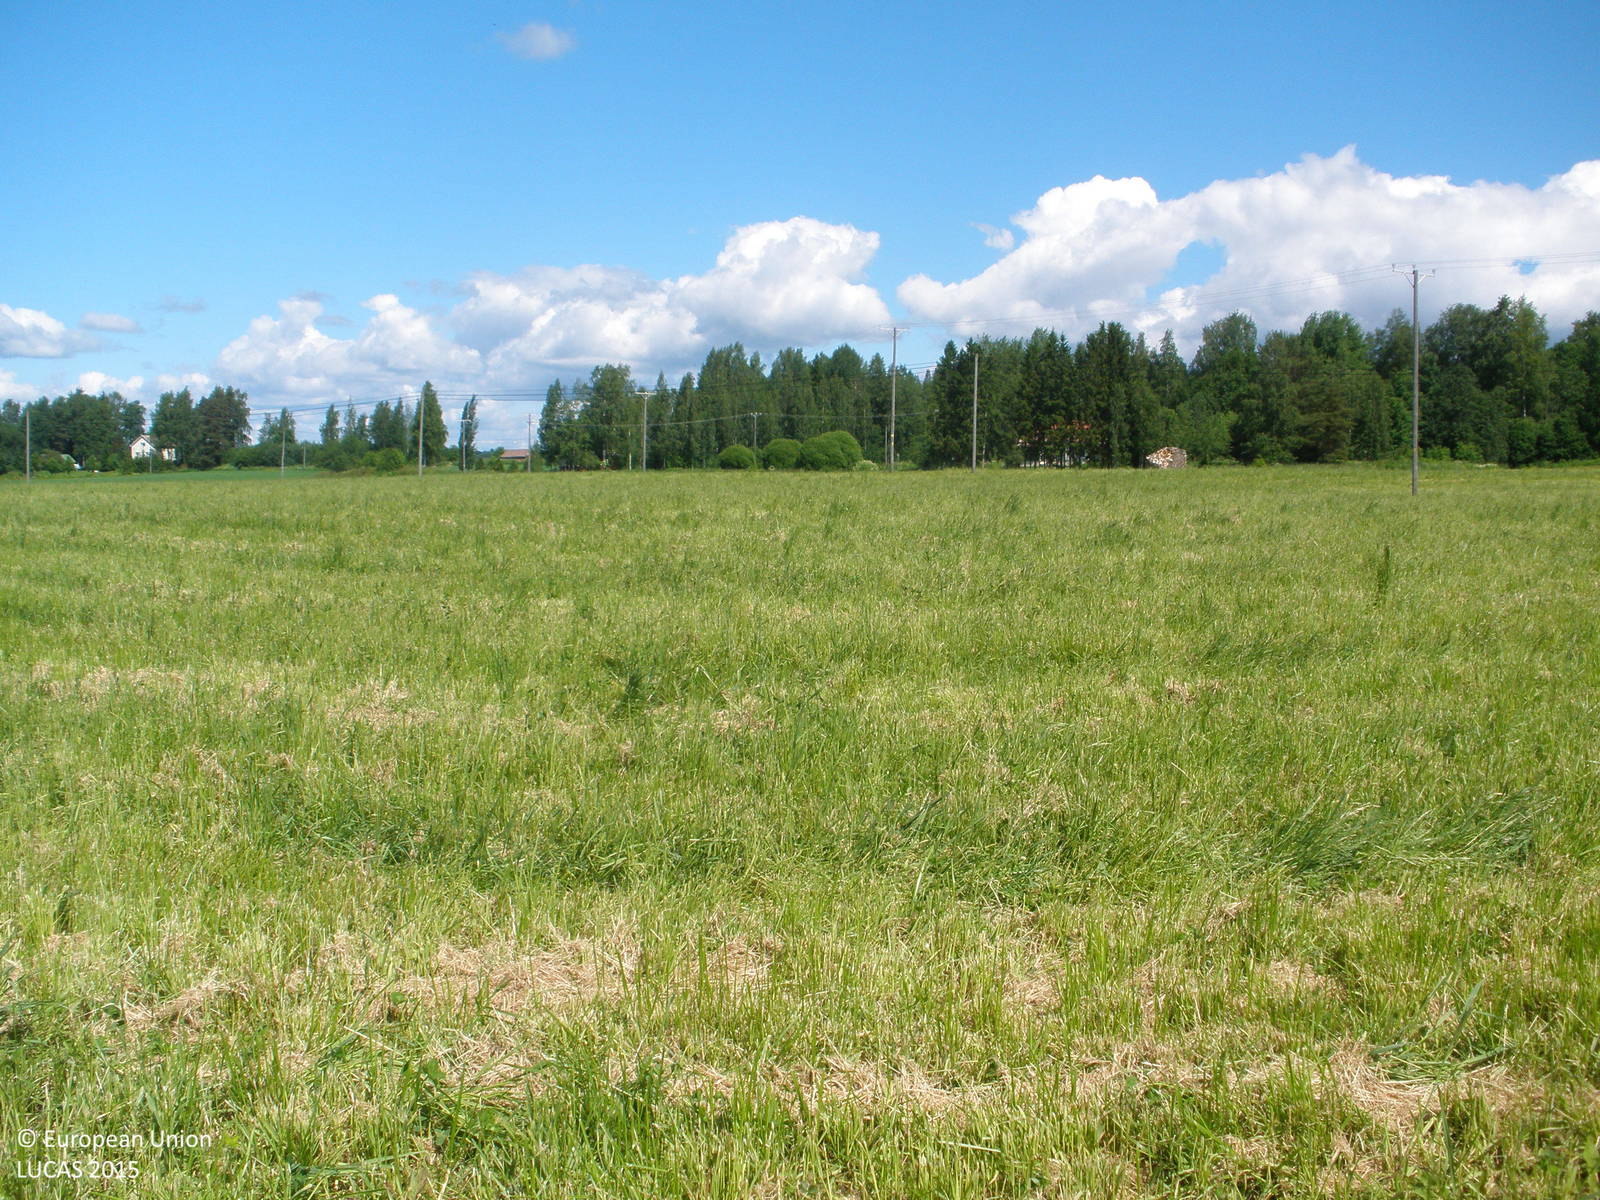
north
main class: Grassland
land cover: Grassland without tree/shrub cover
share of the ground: > 75 %
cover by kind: herbaceous plants 100 %
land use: Agriculture (excluding fallow land and kitchen gardens)
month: June
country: FI
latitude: 61.0751
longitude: 24.1628
